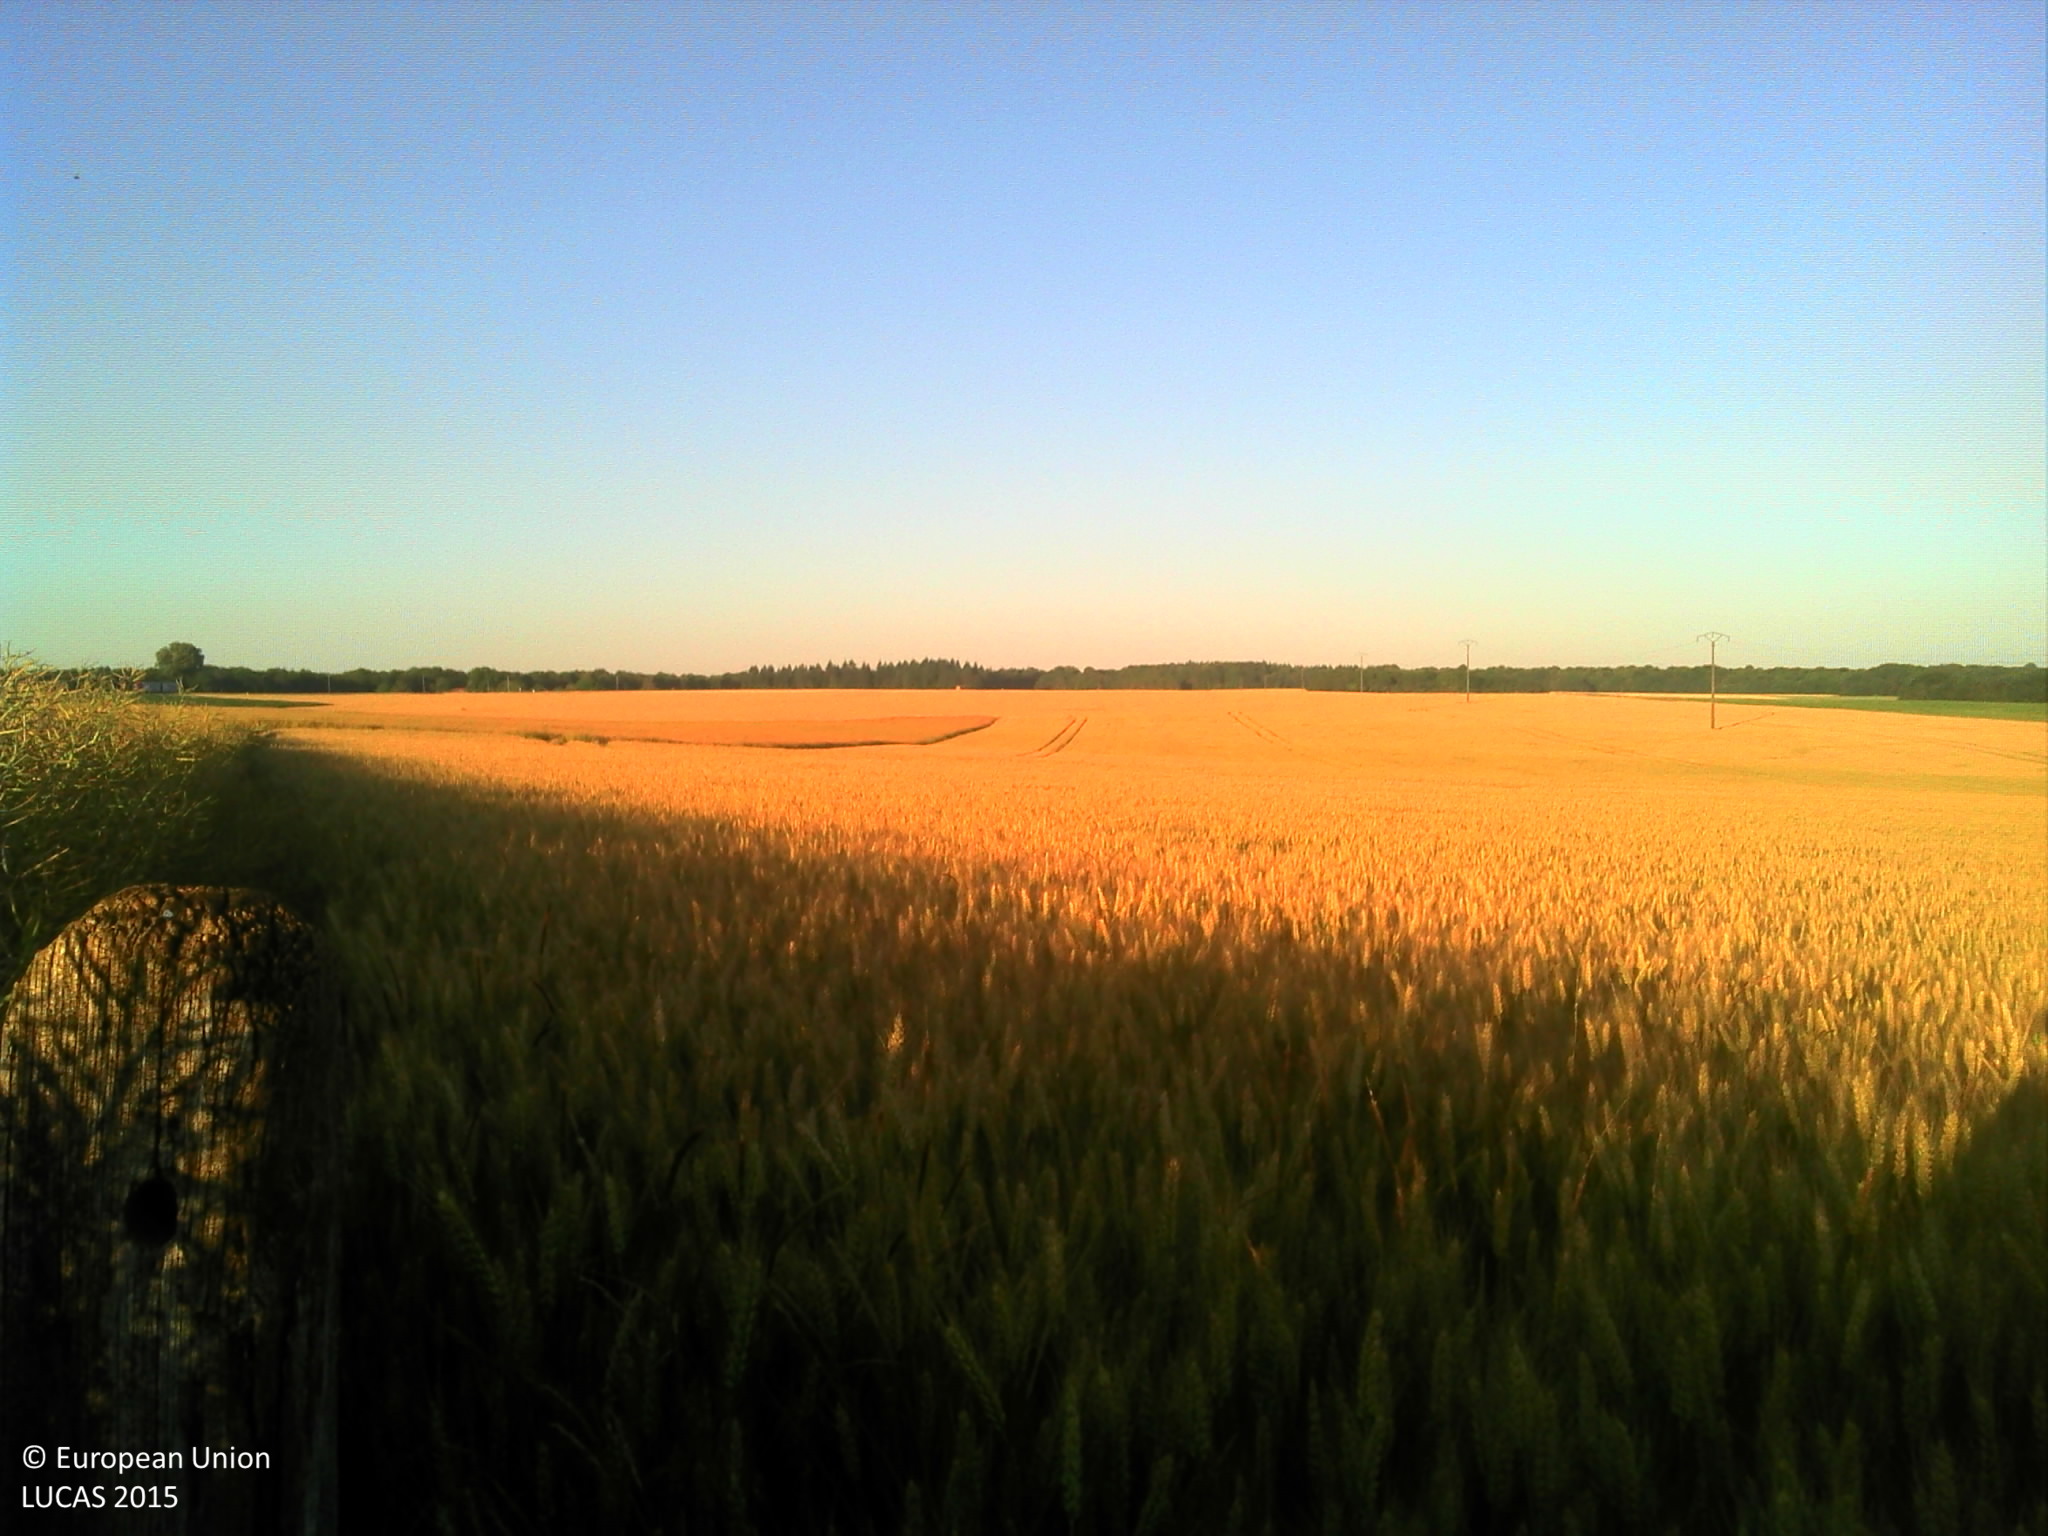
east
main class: Cropland
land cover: Rape and turnip rape
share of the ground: > 75 %
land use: Agriculture (excluding fallow land and kitchen gardens)
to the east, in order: Rape and turnip rape; Common wheat; Grass margins; Paved roads, cycling and walking lanes; Grass margins; Rape and turnip rape
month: June
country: FR
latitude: 48.0363
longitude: 5.3726
